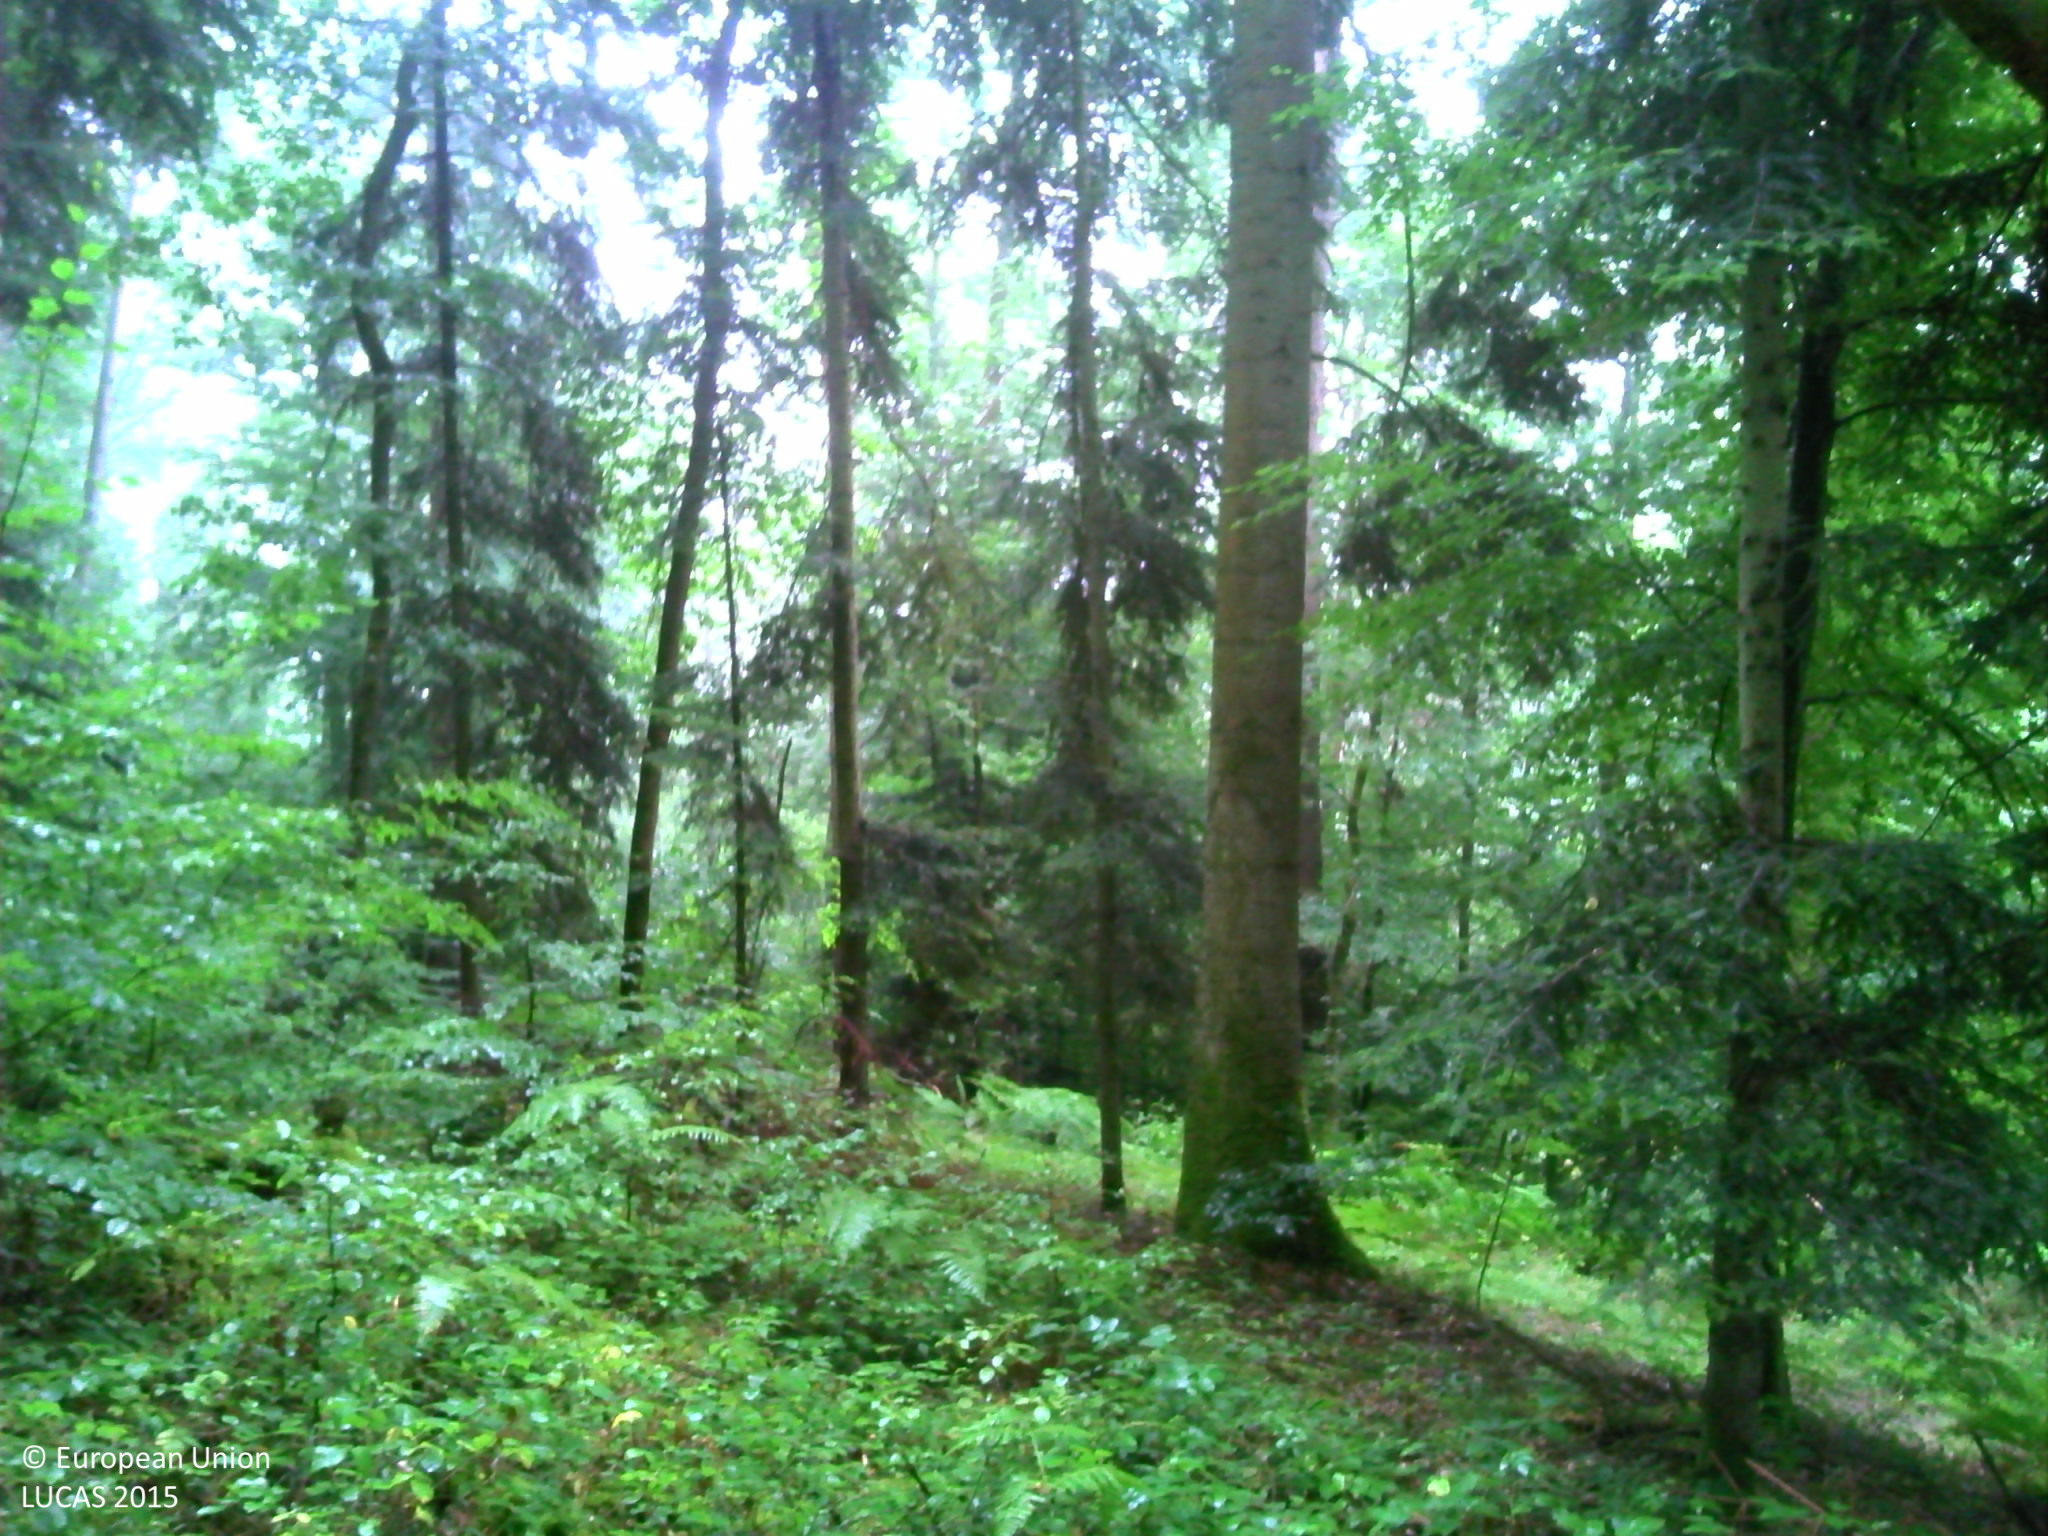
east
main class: Woodland
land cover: Other mixed woodland
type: mountainous beech forest
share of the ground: > 75 %
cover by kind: coniferous forest trees 55 %, broadleaved forest trees 35 %, herbaceous plants 5 %, lichens and mosses 5 %
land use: Forestry
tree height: > 5 m
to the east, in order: Other mixed woodland; Tracks; Other mixed woodland; Tracks; Grass margins; Electric lines; Other mixed woodland; Rivers and streams; Broadleaved woodland; Grass margins; Paved roads, cycling and walking lanes; Grass margins
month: July
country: FR
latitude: 48.9642
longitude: 7.2824
